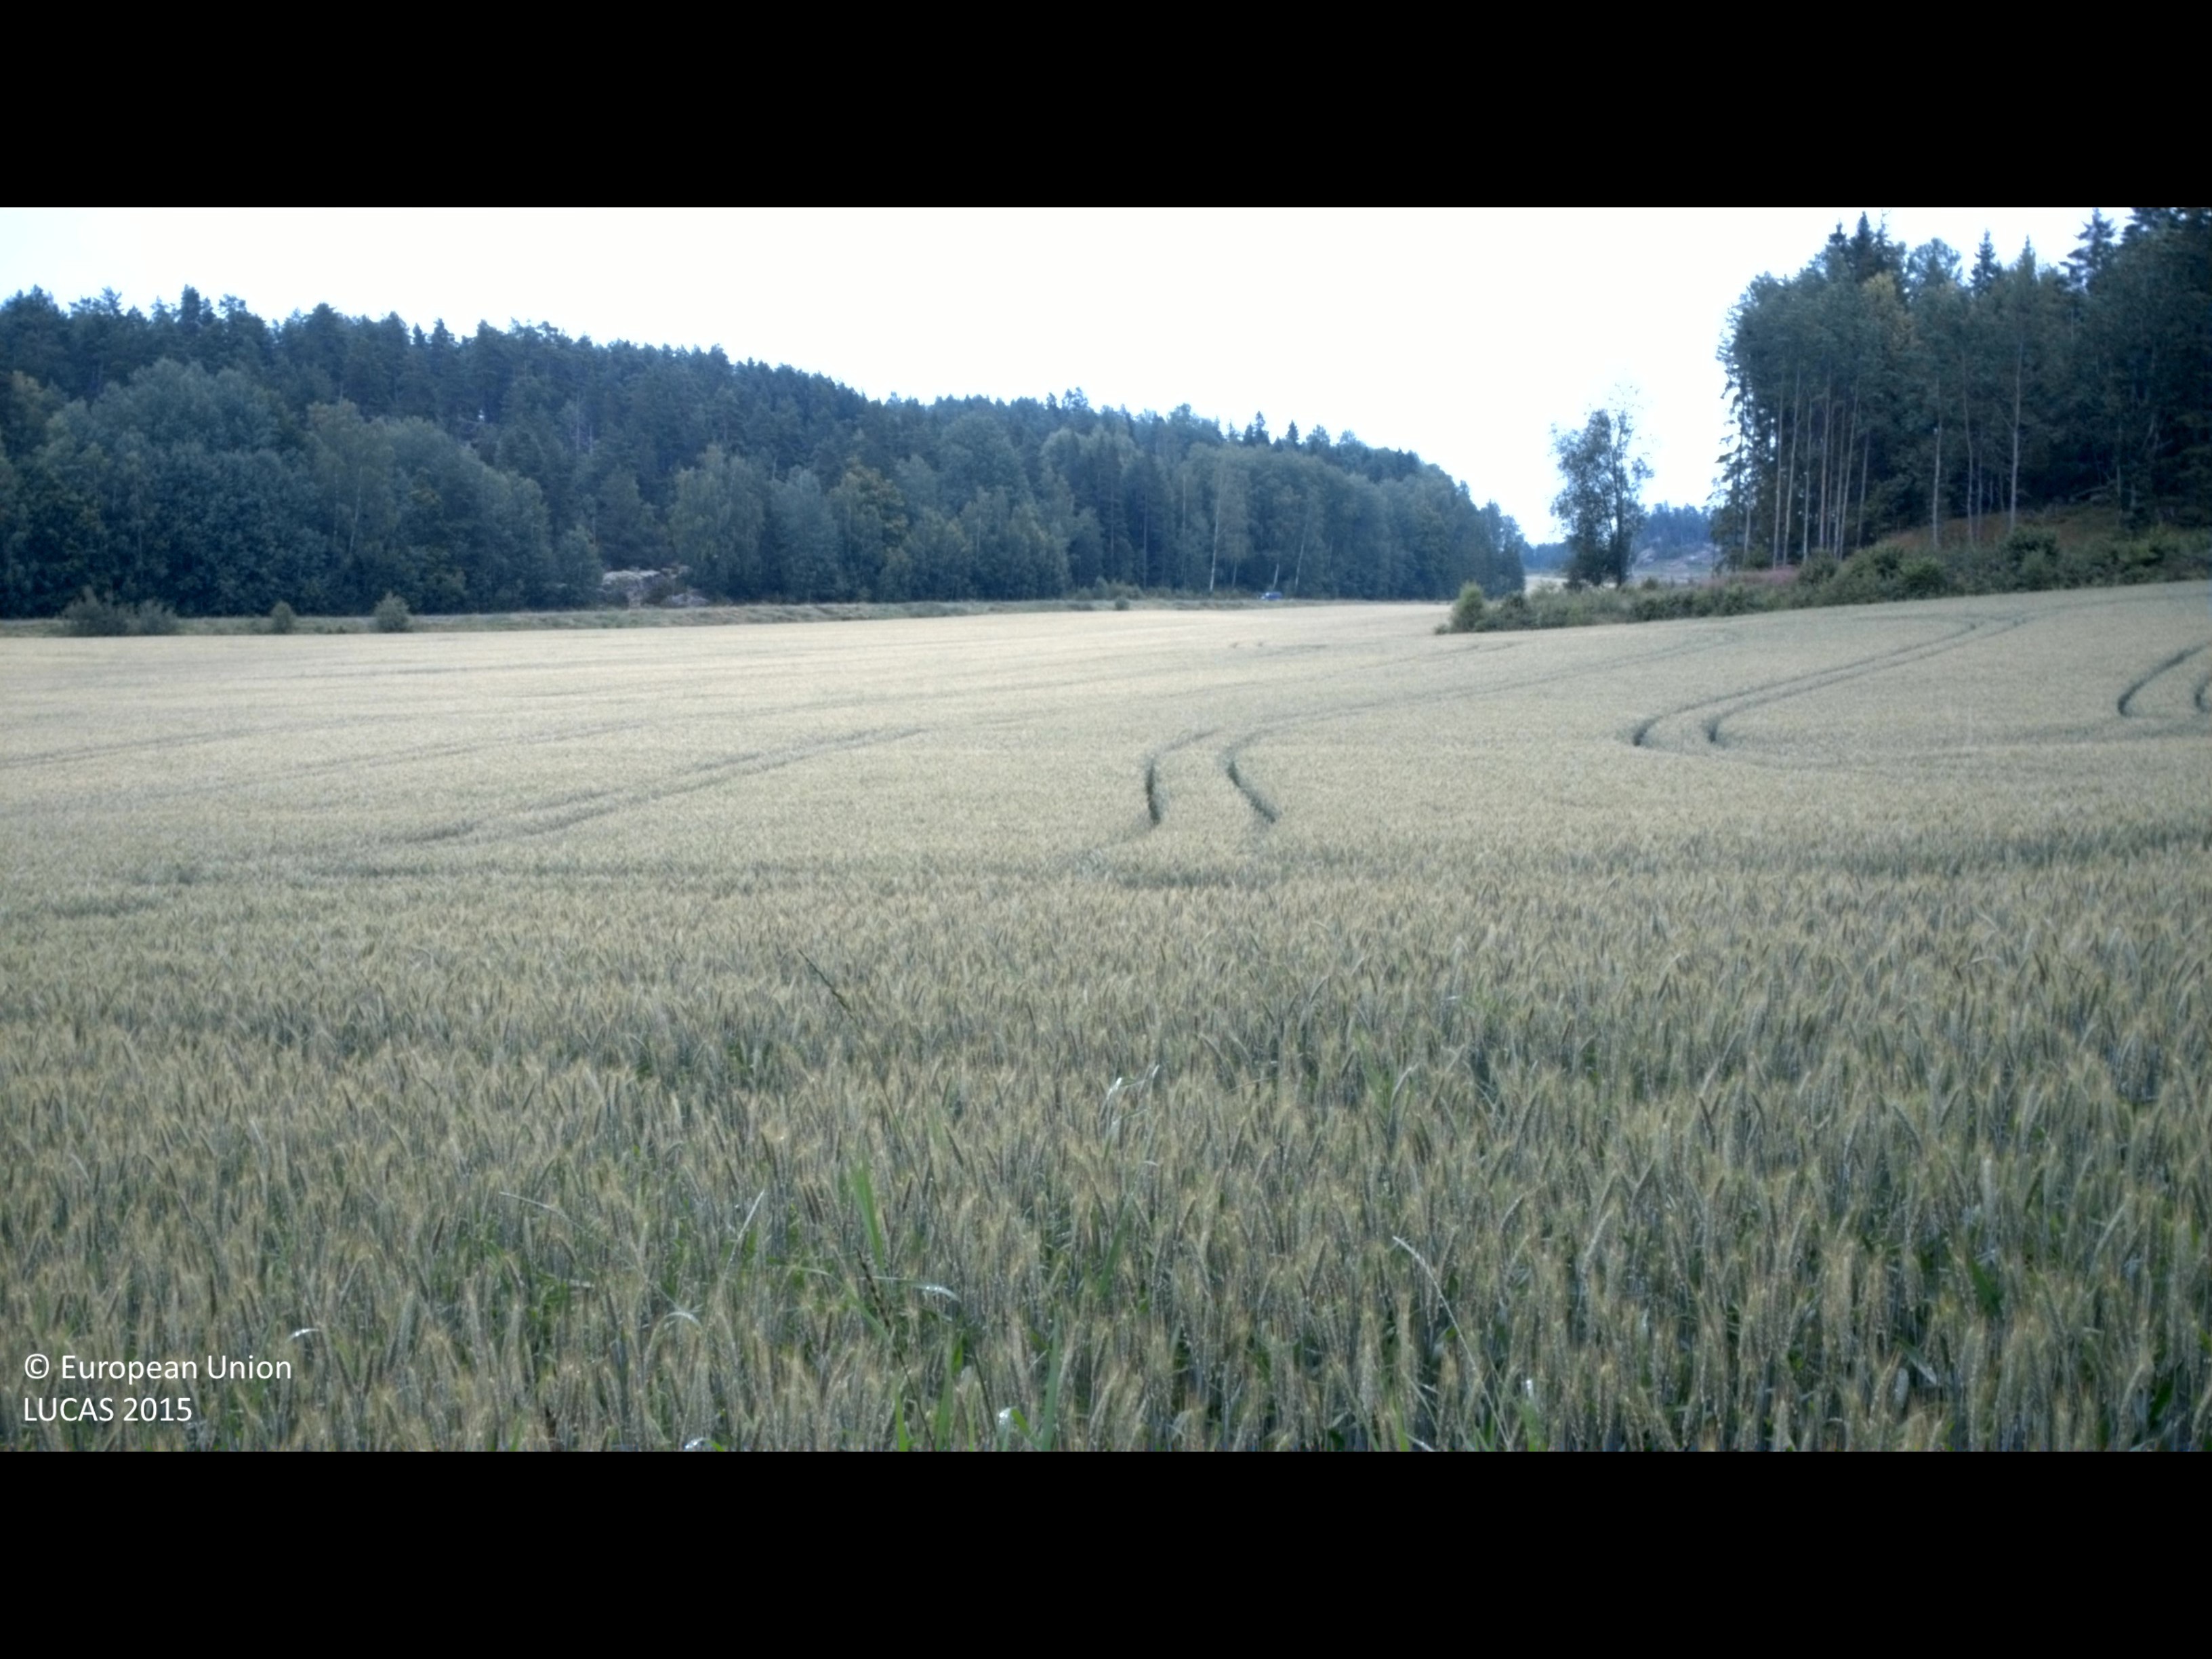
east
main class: Cropland
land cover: Rye
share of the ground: > 75 %
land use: Agriculture (excluding fallow land and kitchen gardens)
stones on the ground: < 10 %
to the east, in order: Rye
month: July
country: SE
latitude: 58.3457
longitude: 16.2317
